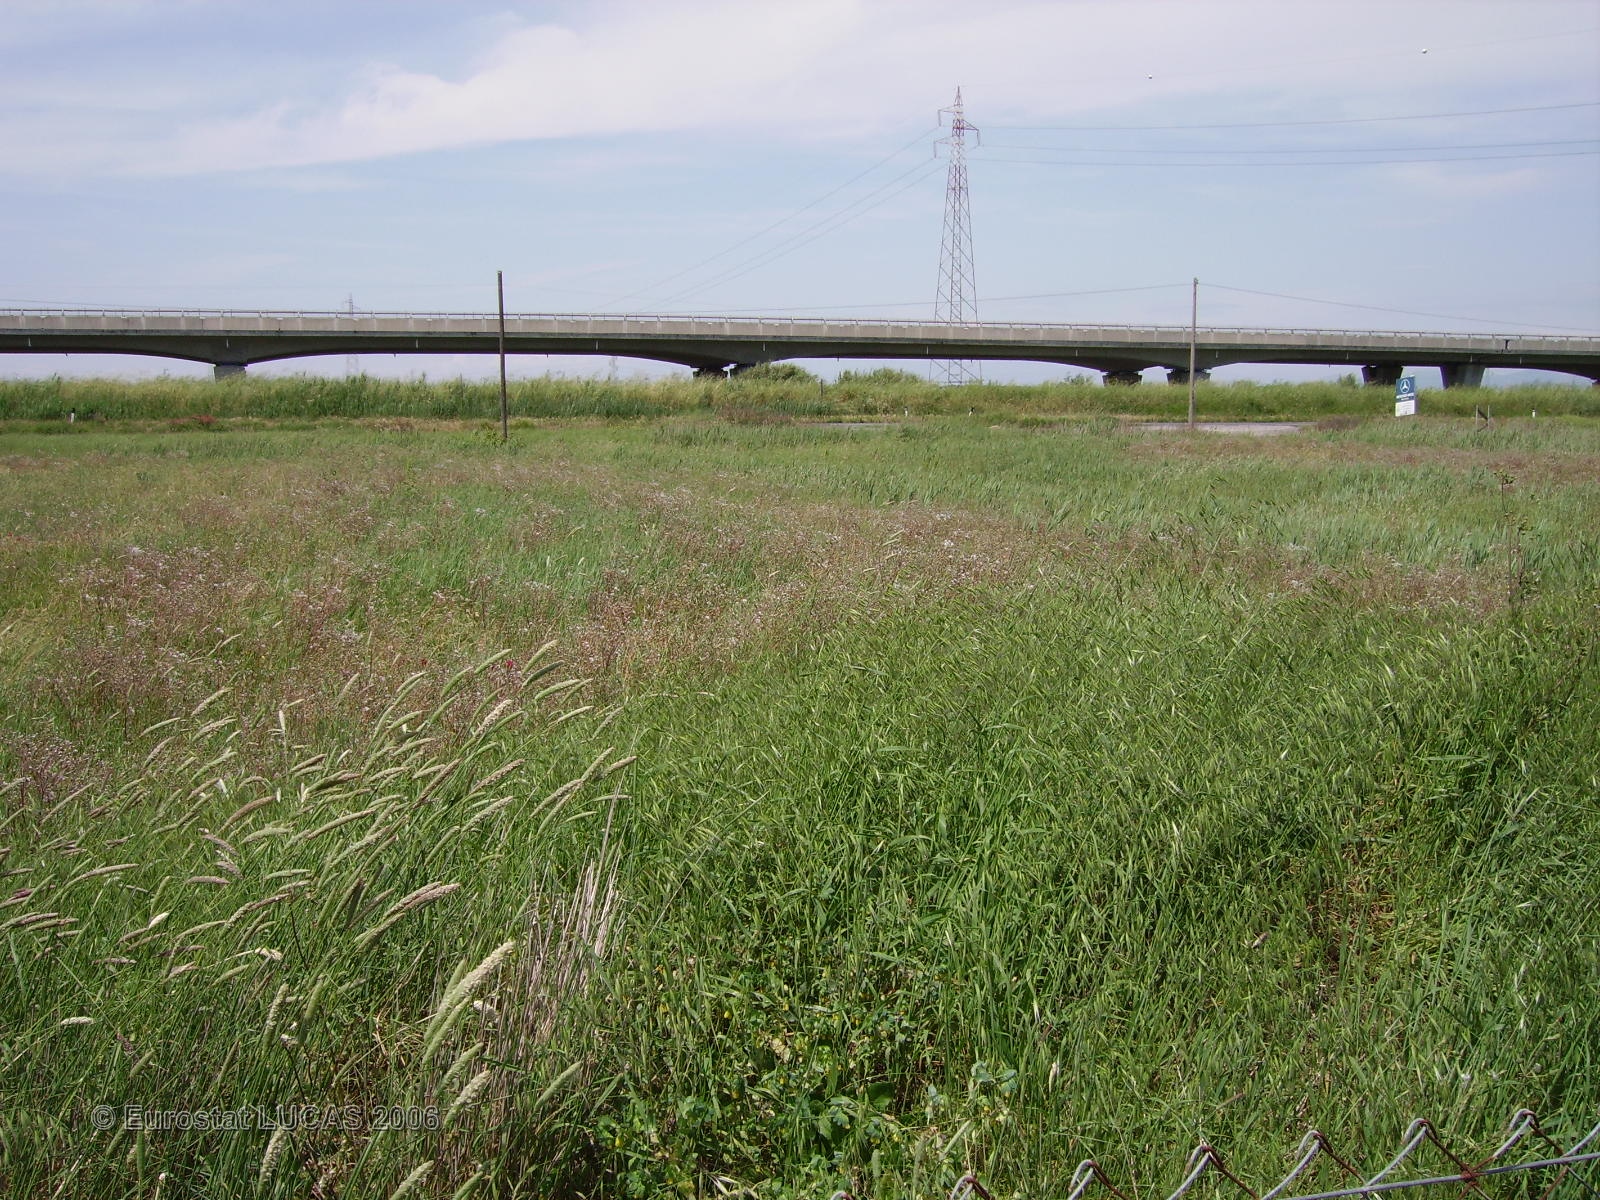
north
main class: Grassland
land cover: Grassland without tree/shrub cover
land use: Agriculture (excluding fallow land and kitchen gardens)
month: May
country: IT
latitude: 43.6101
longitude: 10.3830
